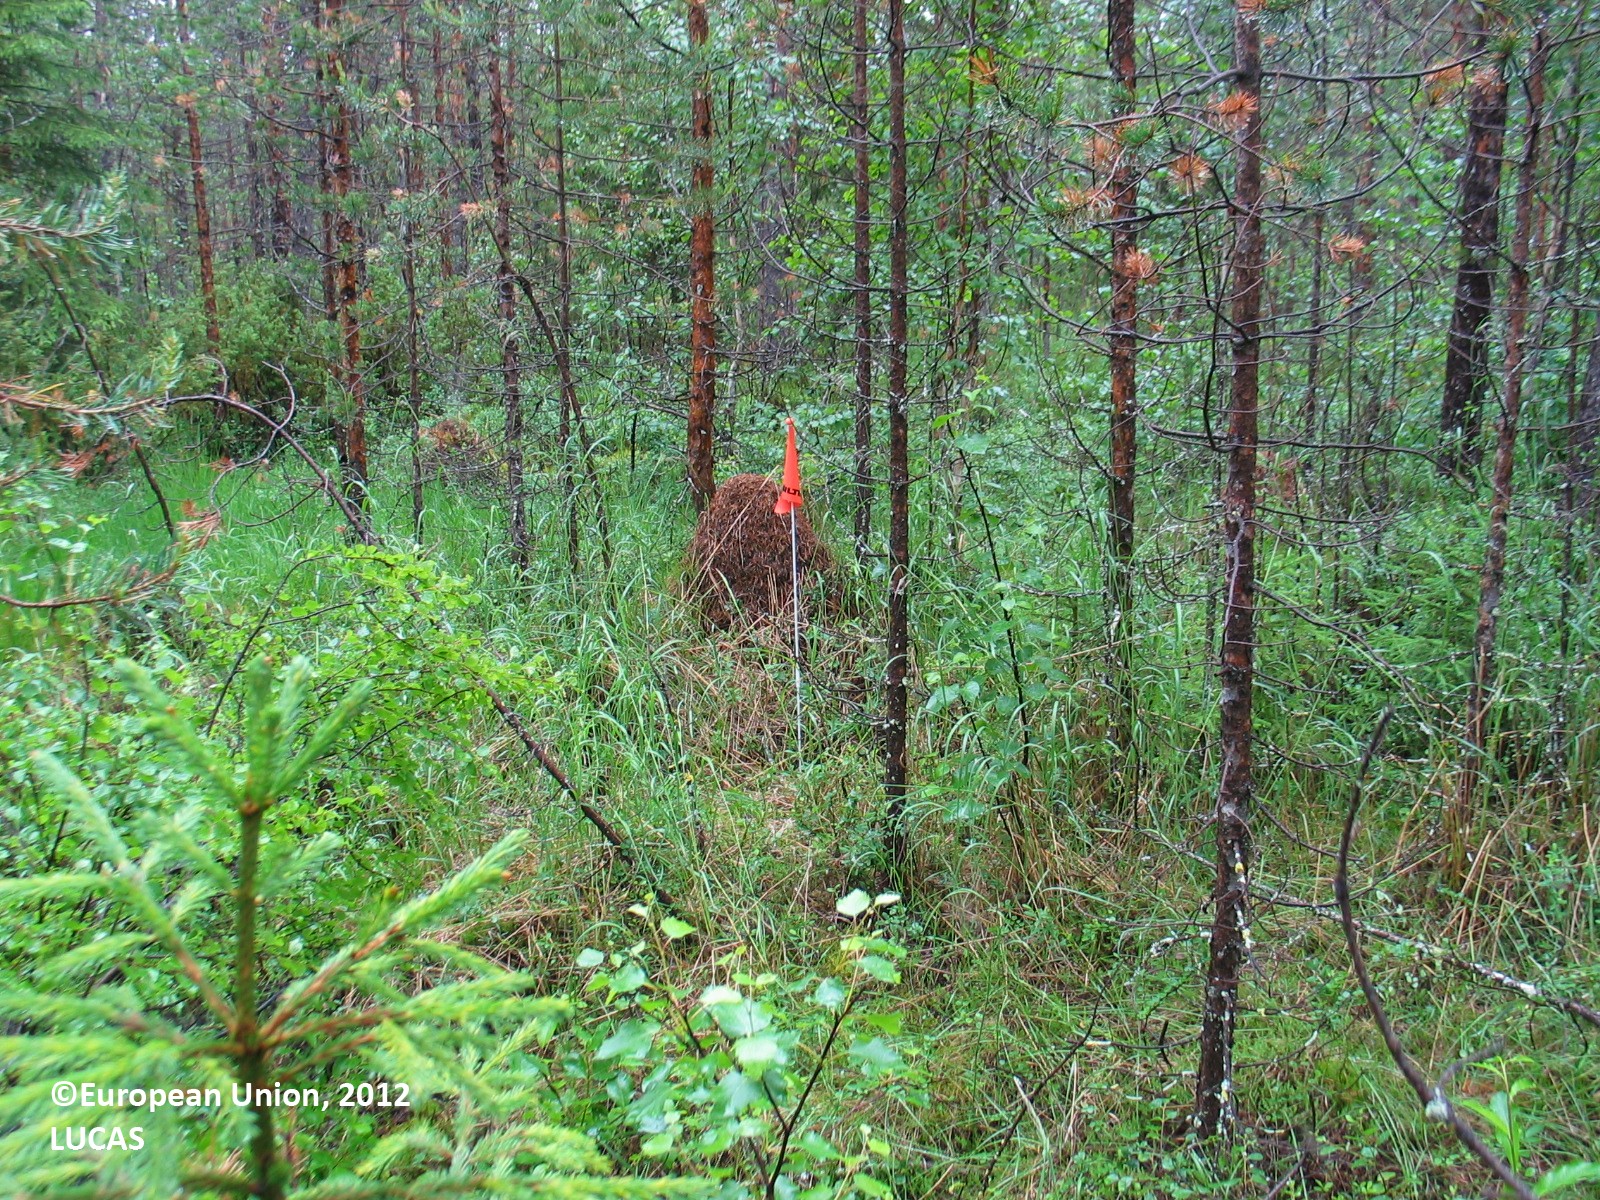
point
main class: Woodland
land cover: Pine dominated coniferous woodland
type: mire and swamp forests
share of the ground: 50 - 75 %
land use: Forestry
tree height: > 5 m
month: July
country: FI
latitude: 66.0735
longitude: 24.8843
